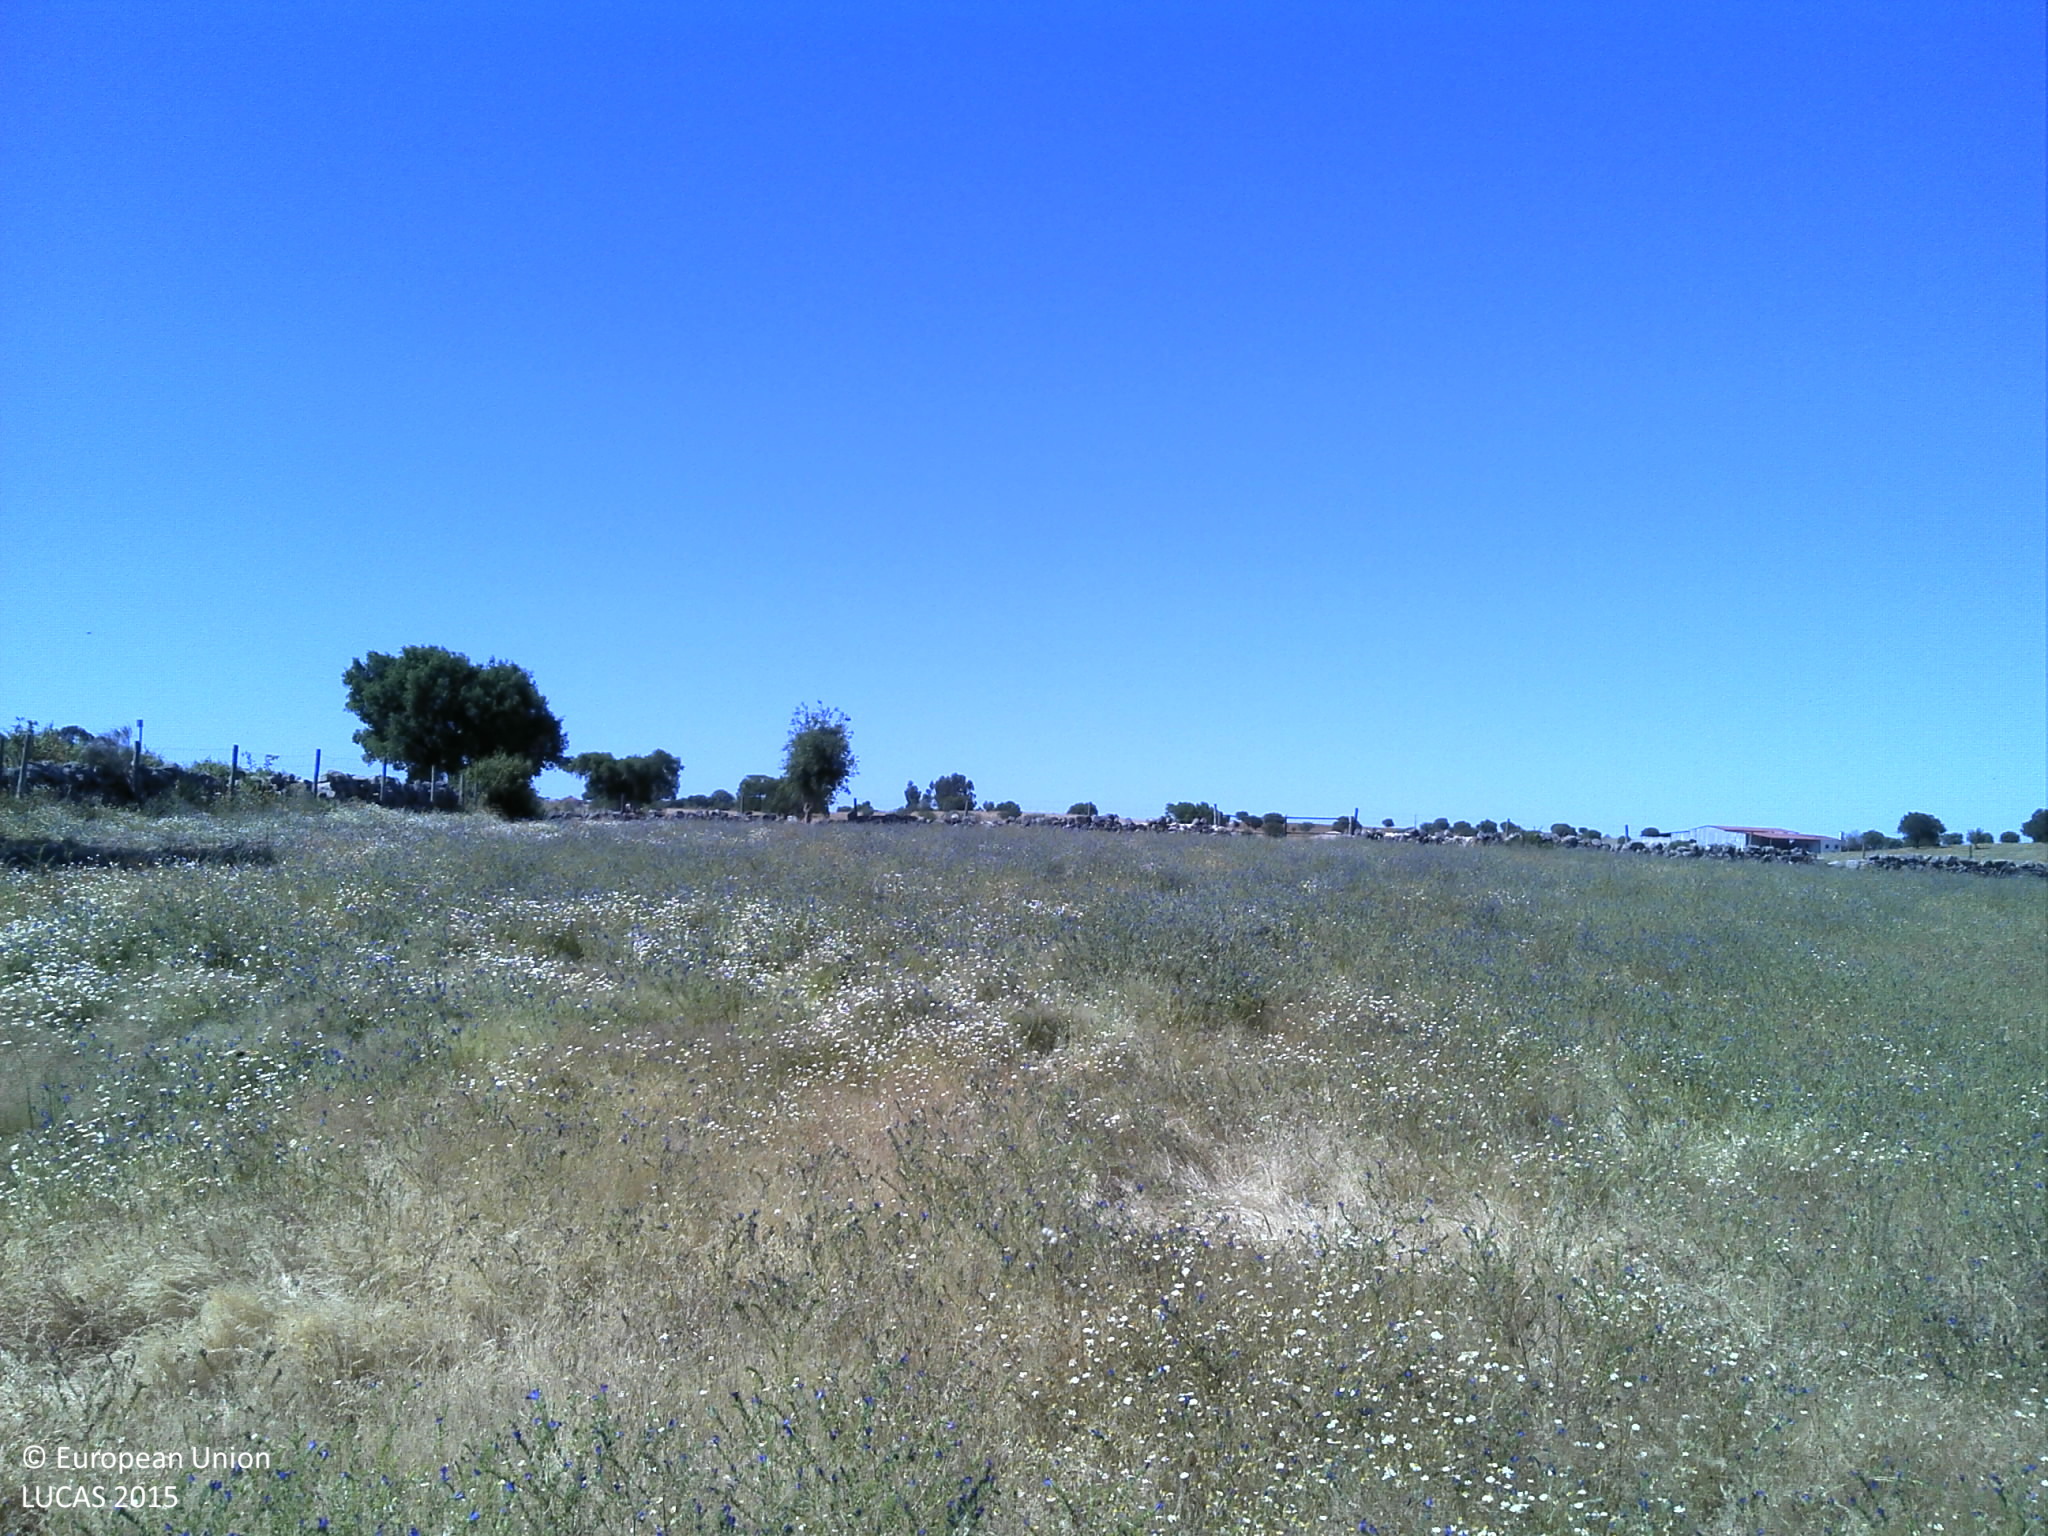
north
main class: Grassland
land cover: Grassland without tree/shrub cover
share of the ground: > 75 %
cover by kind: herbaceous plants 90 %, unconsolidated bare surface 10 %
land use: Agriculture (excluding fallow land and kitchen gardens)
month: May
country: PT
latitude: 39.3985
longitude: -7.7121
